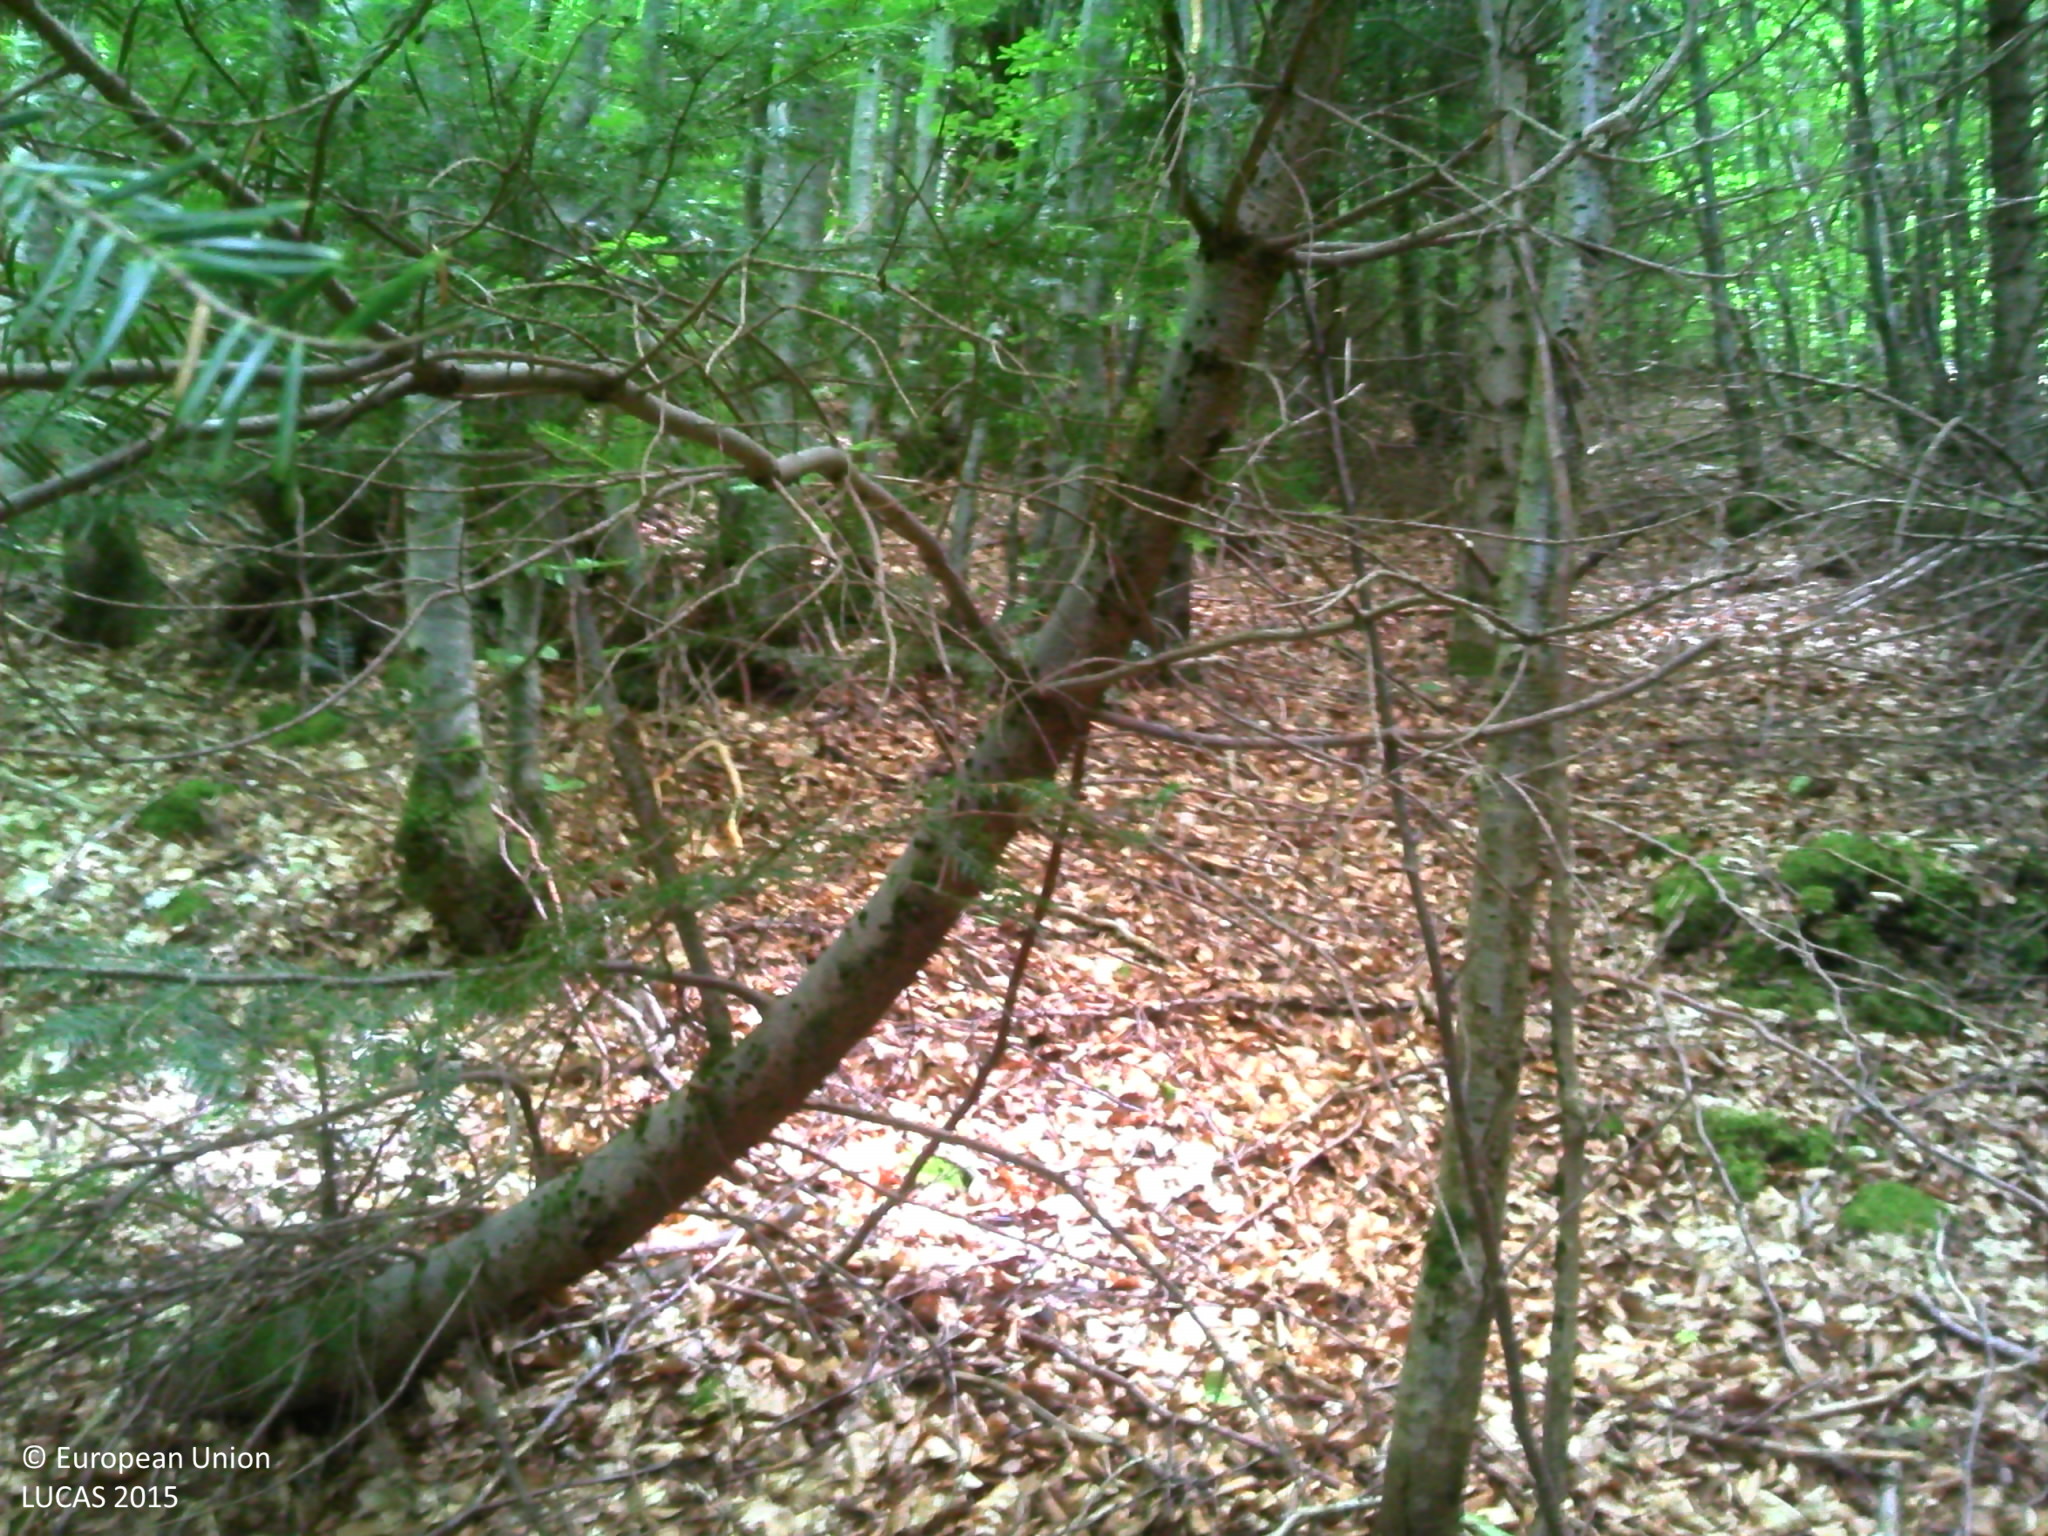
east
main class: Woodland
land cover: Other mixed woodland
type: mountainous beech forest
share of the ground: > 75 %
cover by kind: coniferous forest trees 65 %, broadleaved forest trees 35 %
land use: Forestry
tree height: > 5 m
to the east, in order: Other mixed woodland; Broadleaved woodland; Spruce dominated coniferous woodland; Tracks; Spruce dominated coniferous woodland
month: June
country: FR
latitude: 44.6032
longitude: 3.8698
